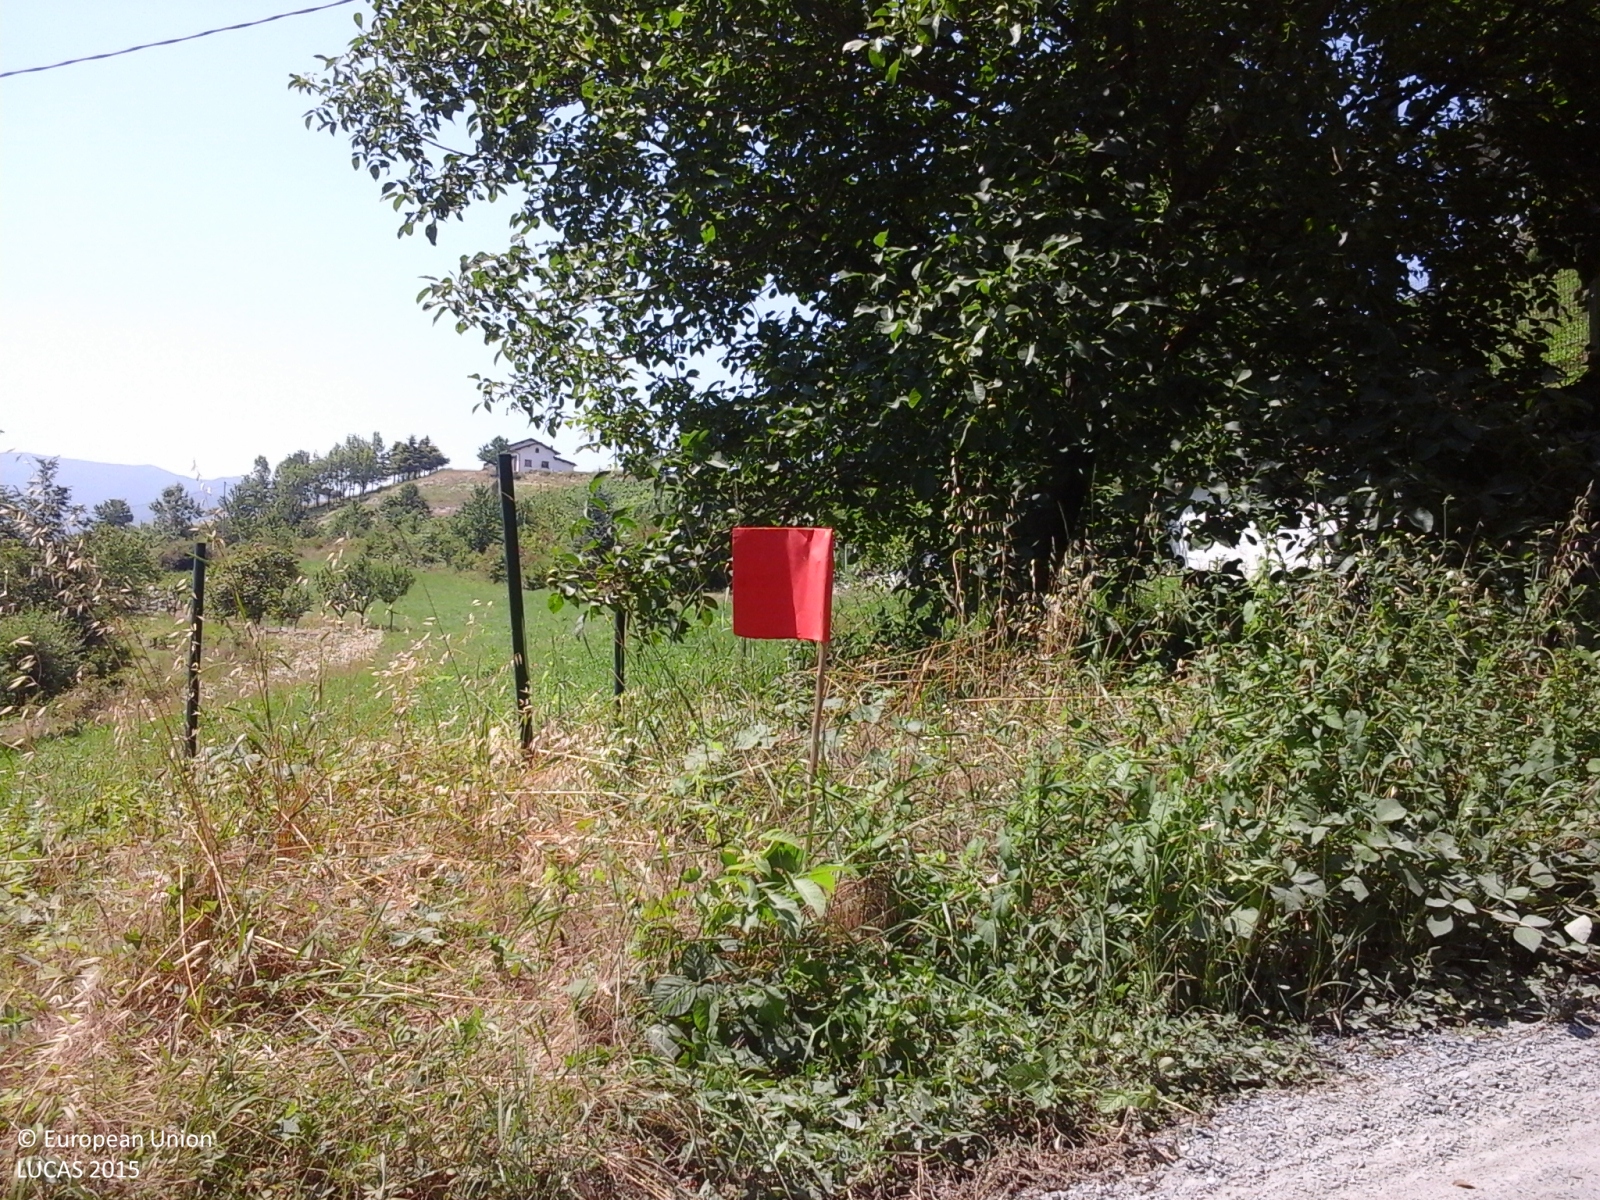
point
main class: Grassland
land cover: Grassland with sparse tree/shrub cover
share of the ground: > 75 %
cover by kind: herbaceous plants 95 %, broadleaved forest trees 5 %
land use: Agriculture (excluding fallow land and kitchen gardens)
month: June
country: IT
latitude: 44.6683
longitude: 8.8042
